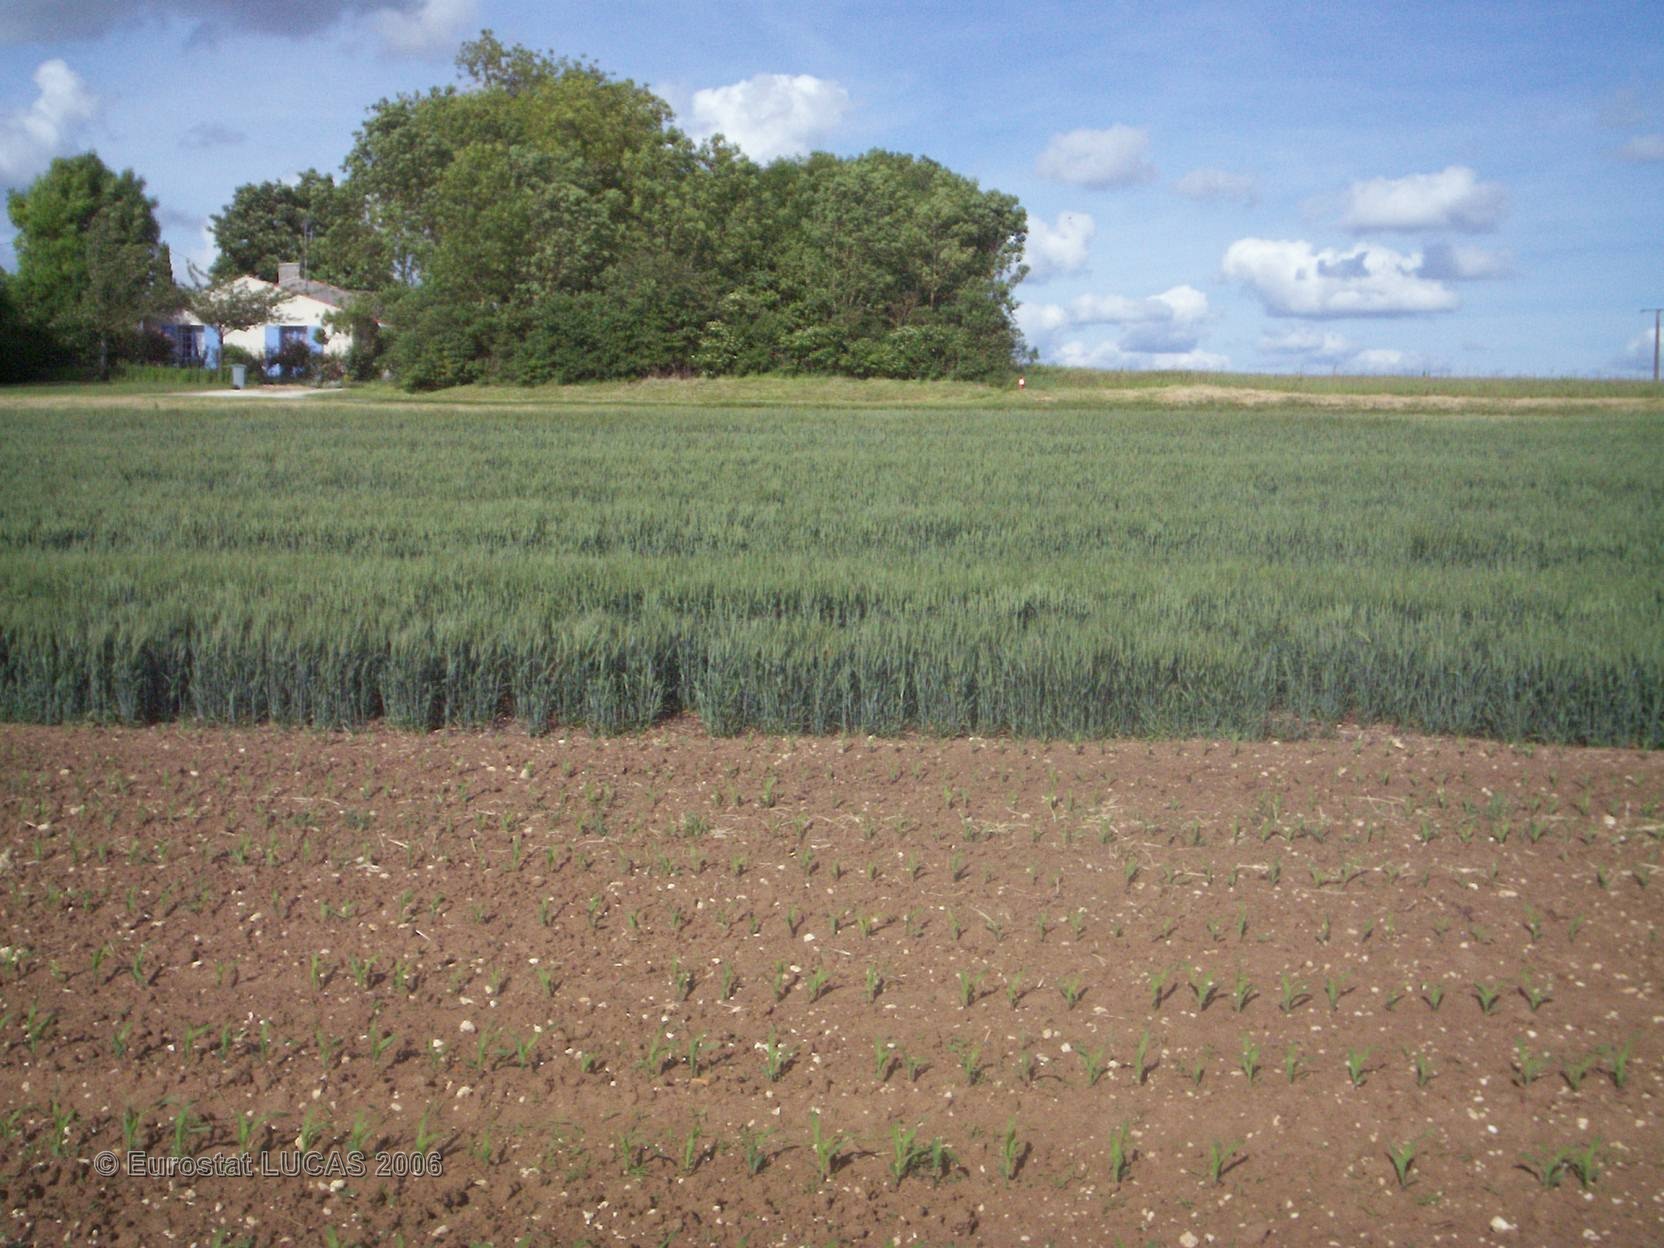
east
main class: Cropland
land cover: Maize
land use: Agriculture (excluding fallow land and kitchen gardens)
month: May
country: FR
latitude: 45.6963
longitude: -0.7744
